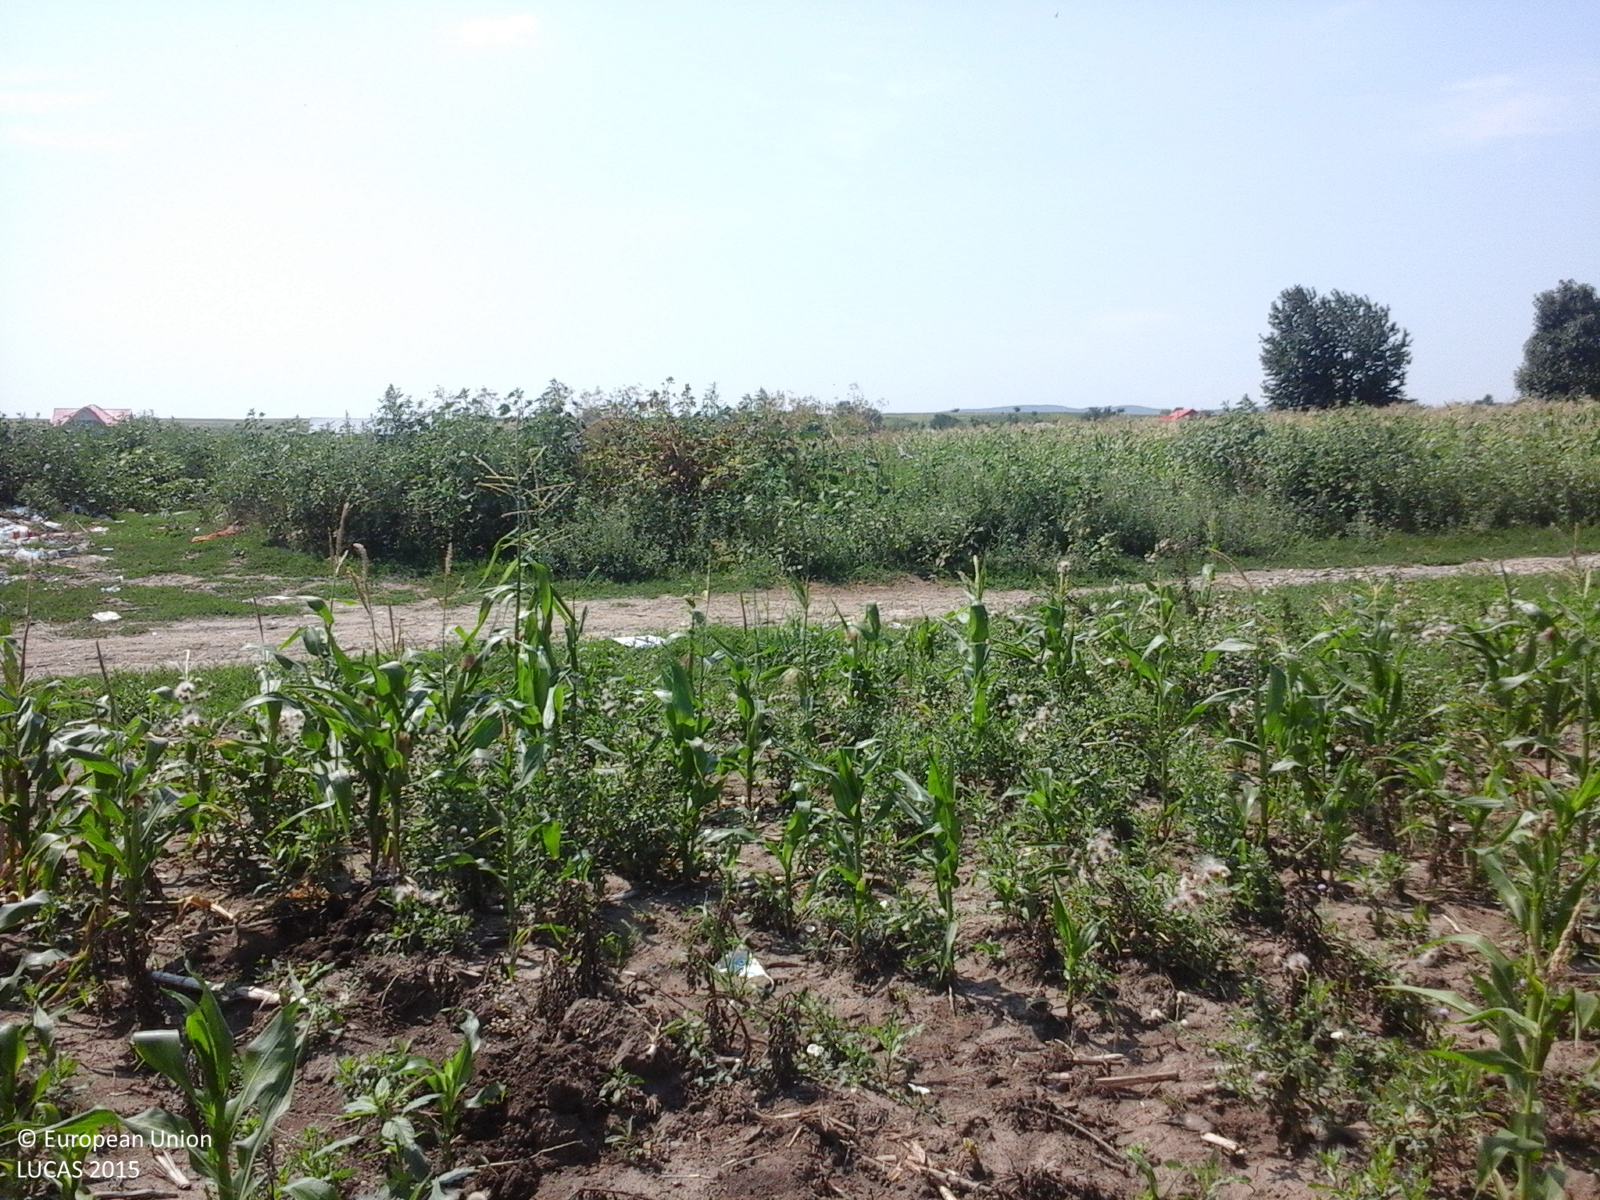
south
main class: Cropland
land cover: Maize
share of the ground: > 75 %
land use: Agriculture (excluding fallow land and kitchen gardens)
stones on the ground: < 10 %
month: August
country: RO
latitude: 46.2135
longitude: 27.0900
